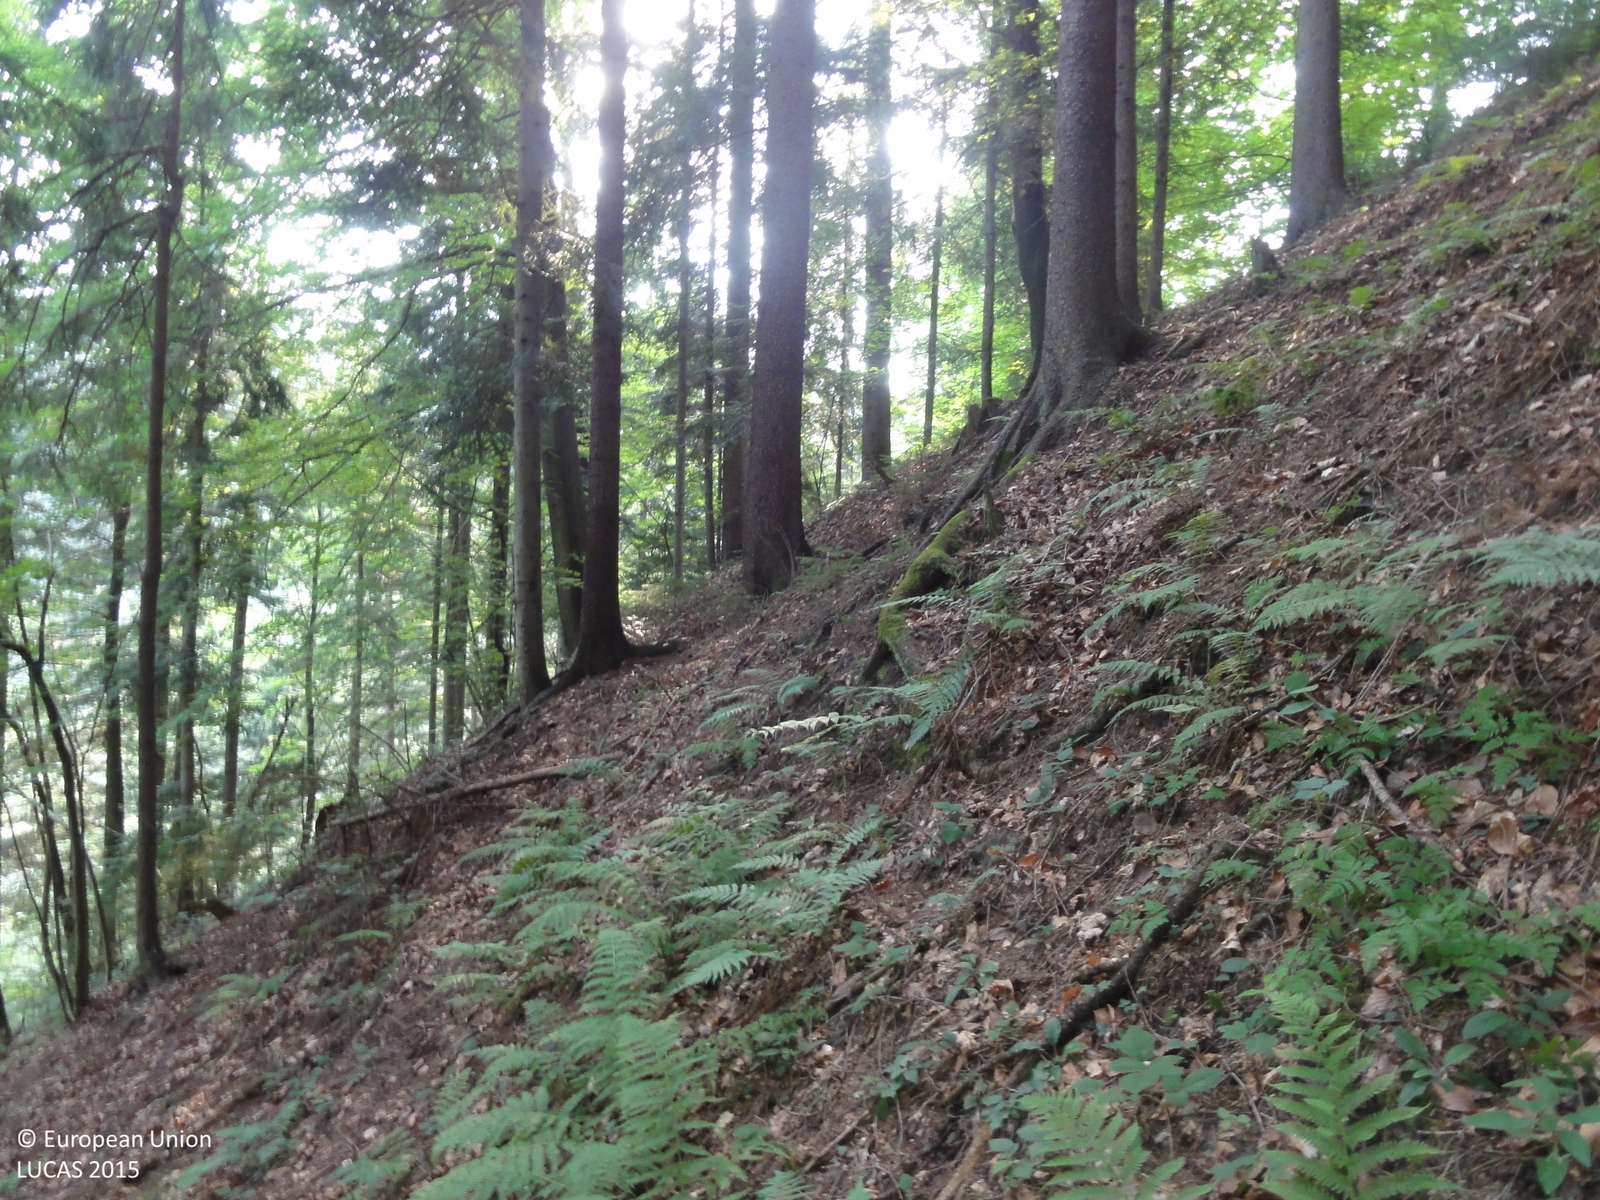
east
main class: Woodland
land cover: Spruce dominated mixed woodland
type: mountainous beech forest
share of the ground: > 75 %
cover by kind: coniferous forest trees 65 %, broadleaved forest trees 35 %
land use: Forestry
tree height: > 5 m
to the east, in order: Spruce dominated mixed woodland; Rivers and streams; Spruce dominated mixed woodland; Tracks; Spruce dominated mixed woodland; Tracks; Spruce dominated mixed woodland; Broadleaved woodland
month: July
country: SI
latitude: 46.5532
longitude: 15.1241
